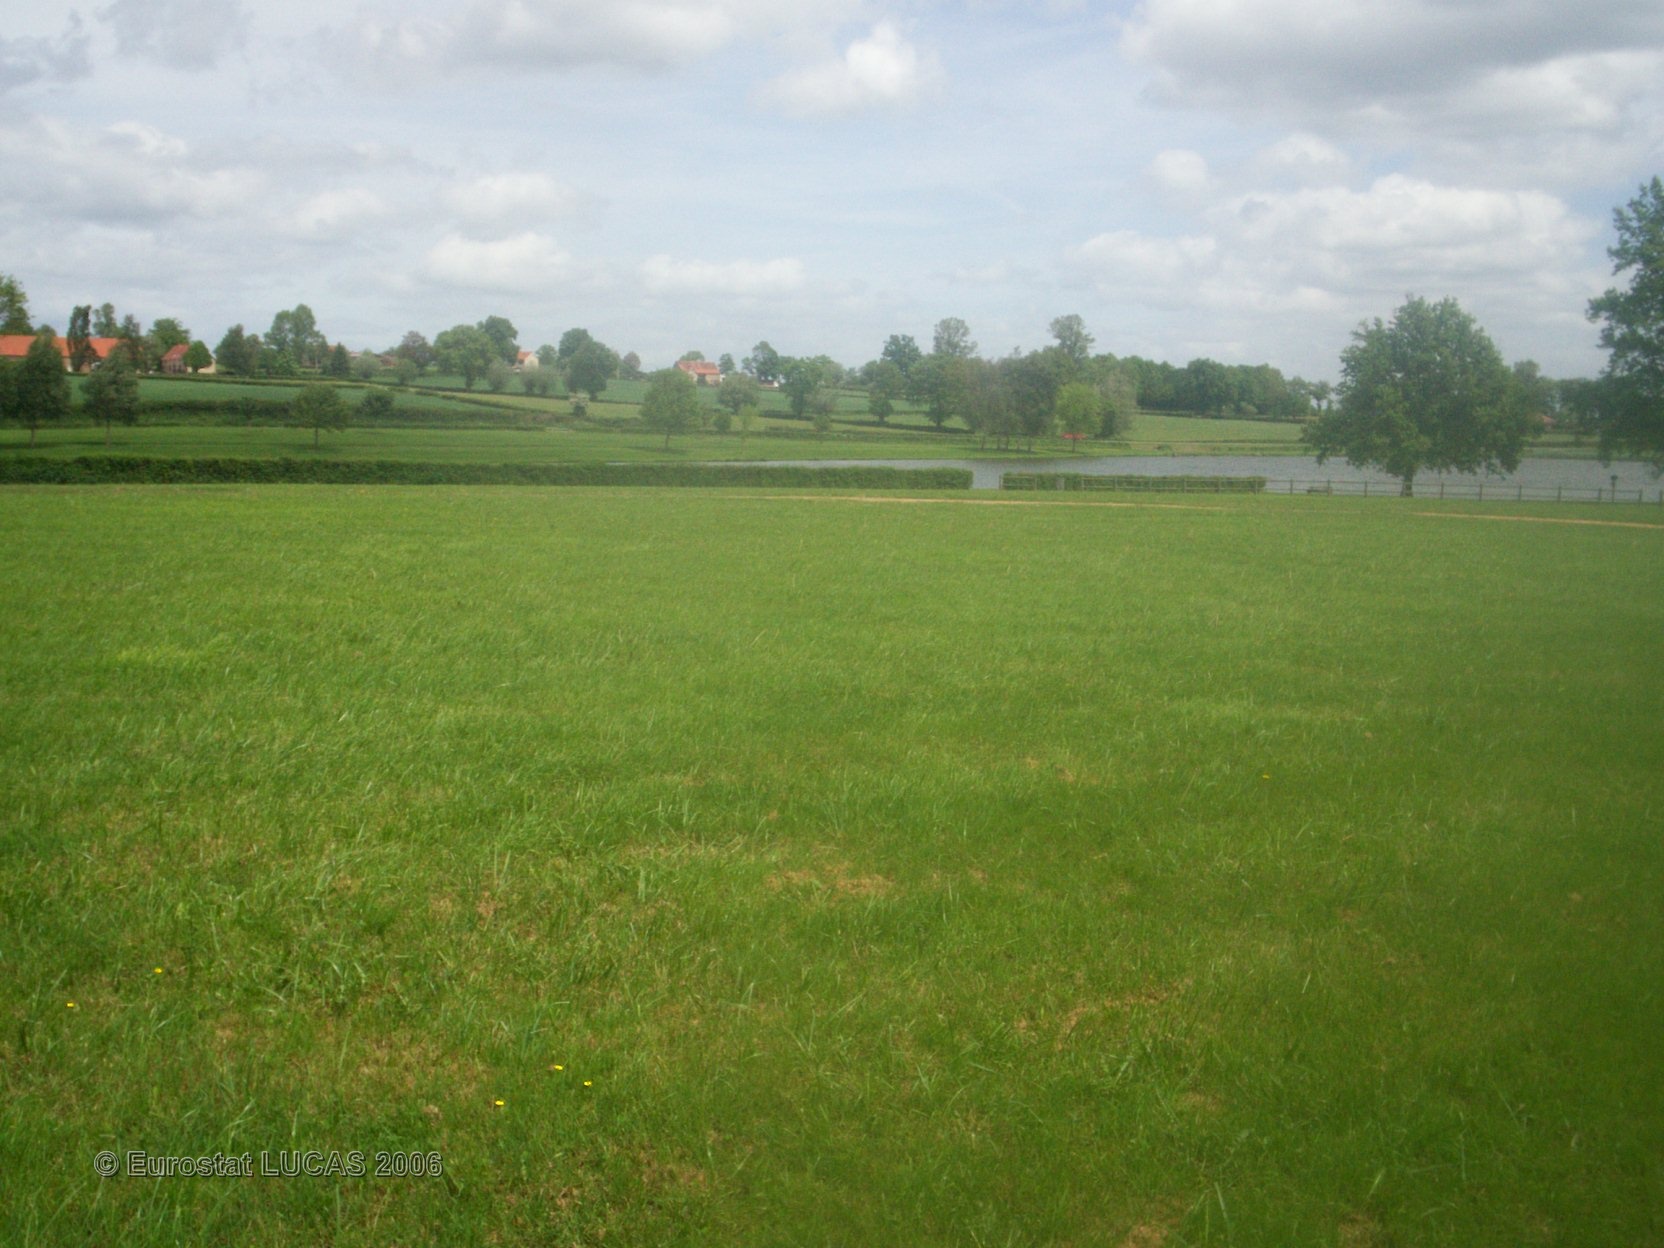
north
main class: Grassland
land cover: Grassland without tree/shrub cover
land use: Agriculture (excluding fallow land and kitchen gardens)
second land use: Amenities, museums, leisure
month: May
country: FR
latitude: 46.2223
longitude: 2.8801
